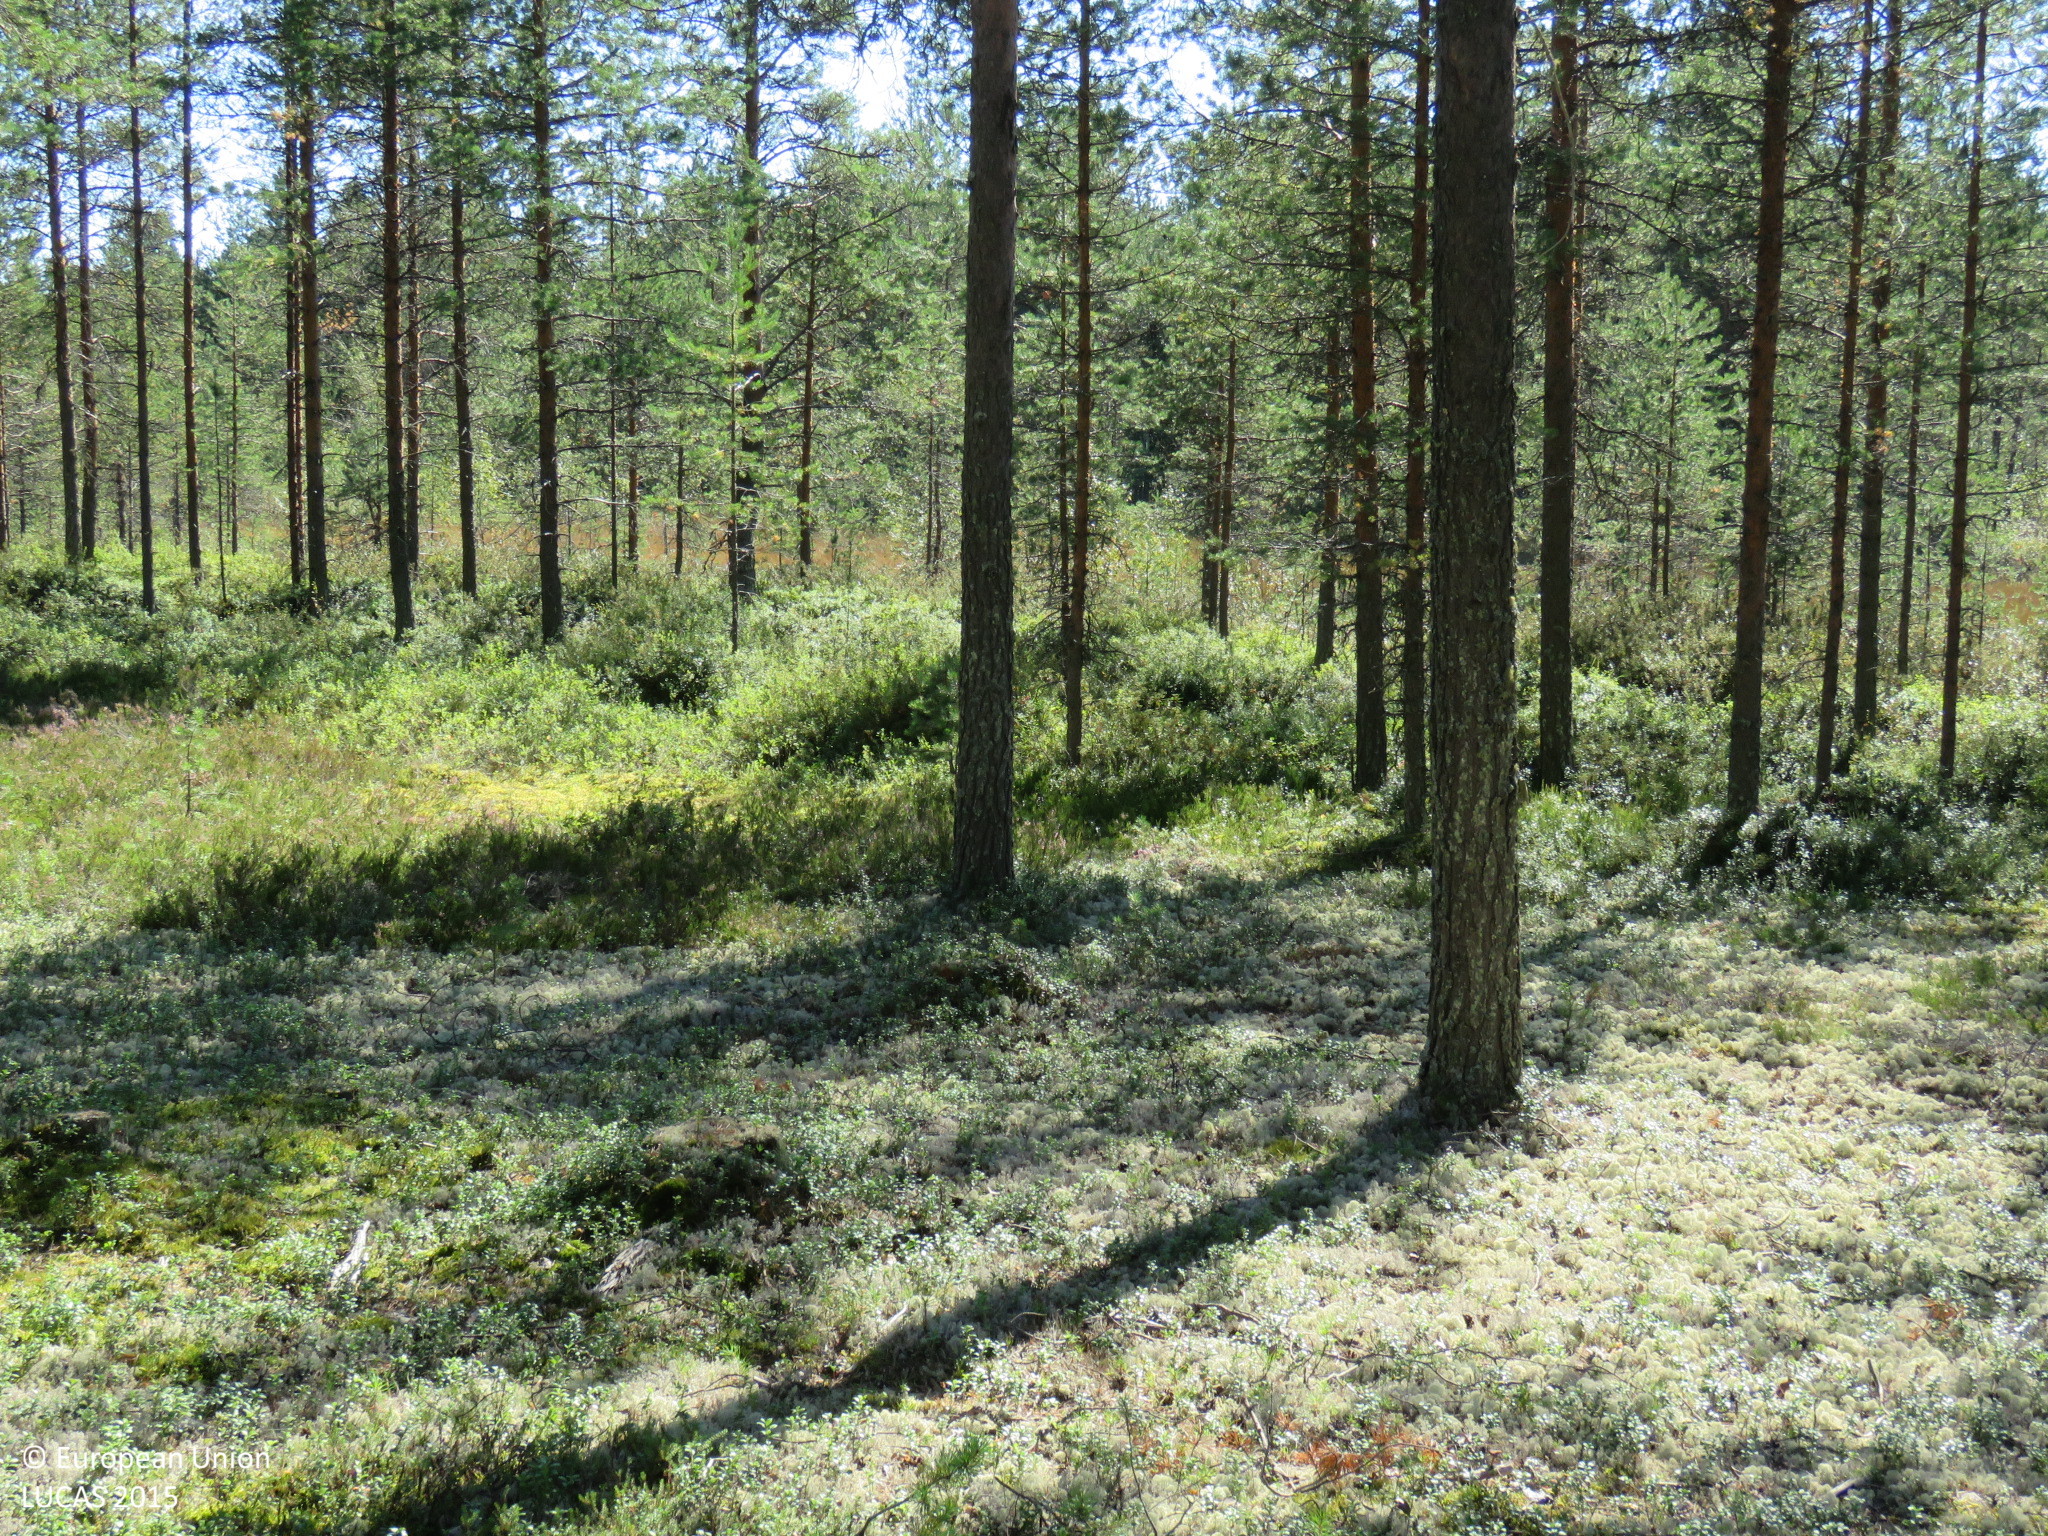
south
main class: Woodland
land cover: Pine dominated coniferous woodland
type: boreal forest
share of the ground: > 75 %
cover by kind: coniferous forest trees 75 %, shrubs 10 %, lichens and mosses 10 %, unconsolidated bare surface 5 %
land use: Forestry
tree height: > 5 m
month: August
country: FI
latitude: 65.1130
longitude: 25.6537
